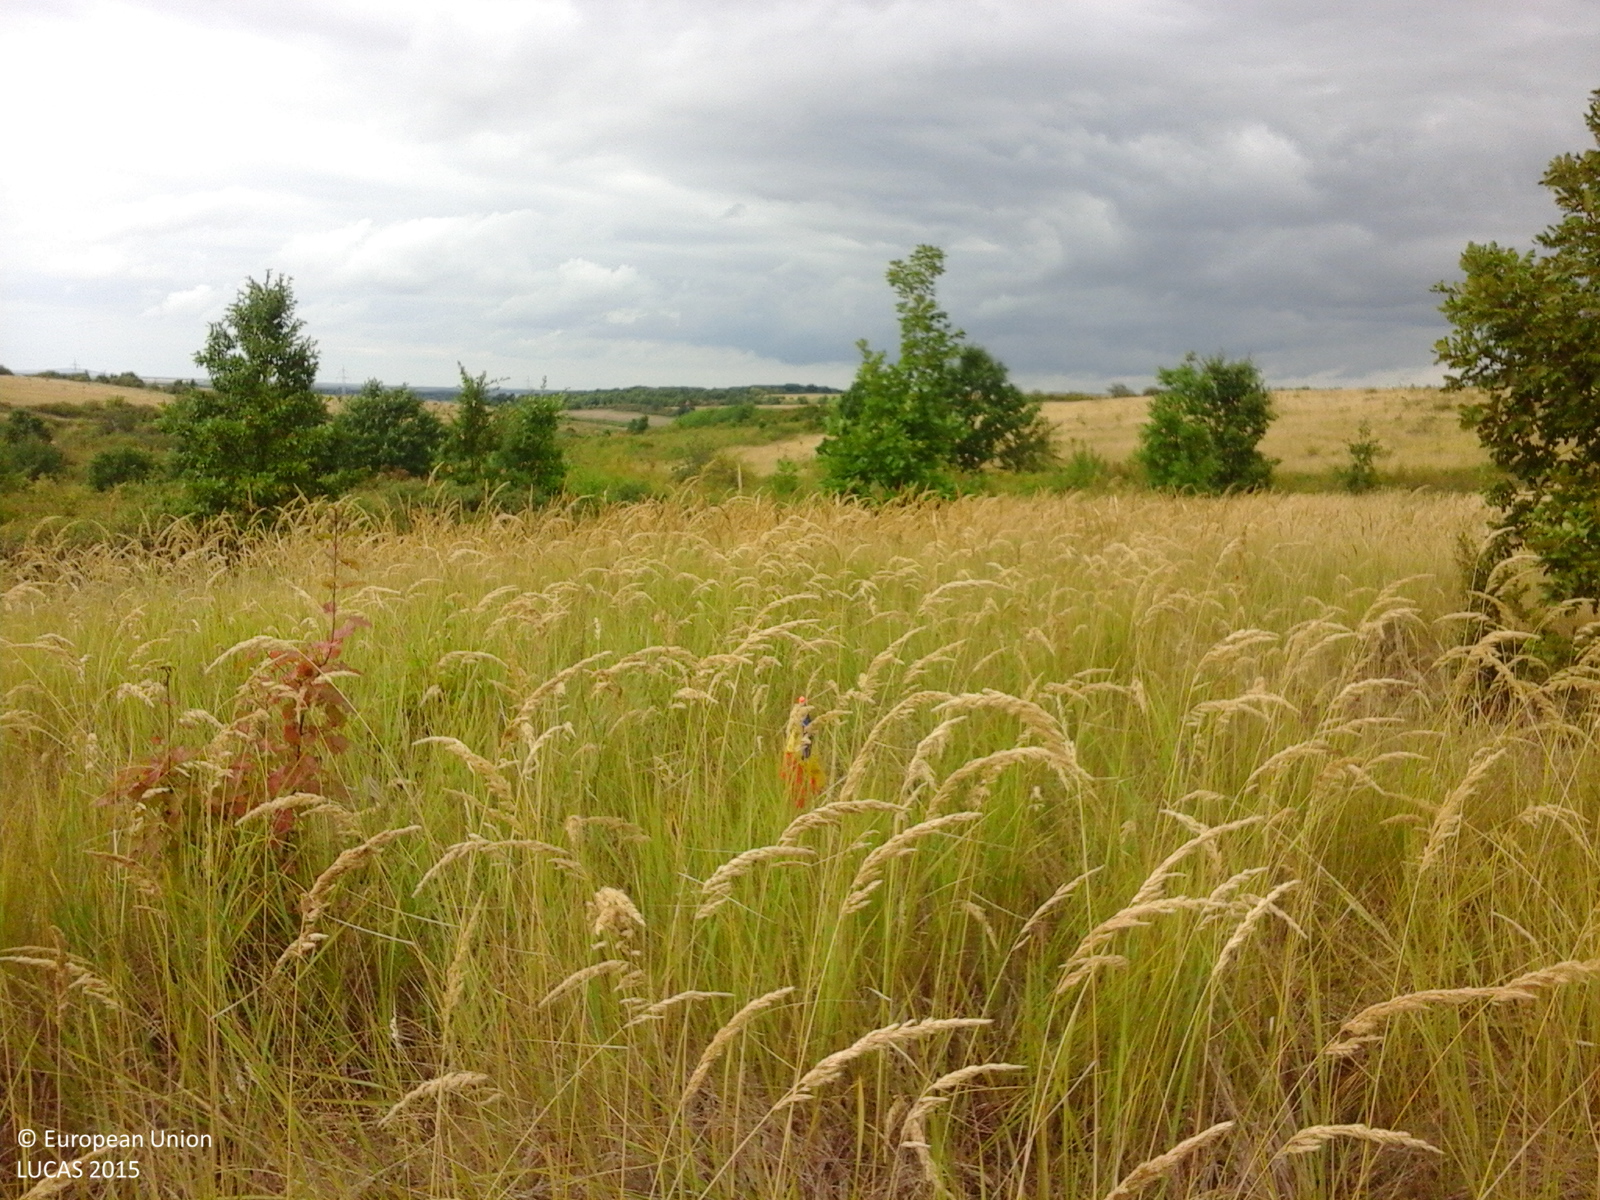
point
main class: Grassland
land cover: Grassland with sparse tree/shrub cover
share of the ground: > 75 %
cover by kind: herbaceous plants 85 %, shrubs 10 %, broadleaved forest trees 5 %
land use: Fallow land
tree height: < 5 m
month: August
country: RO
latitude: 45.4622
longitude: 21.6075
